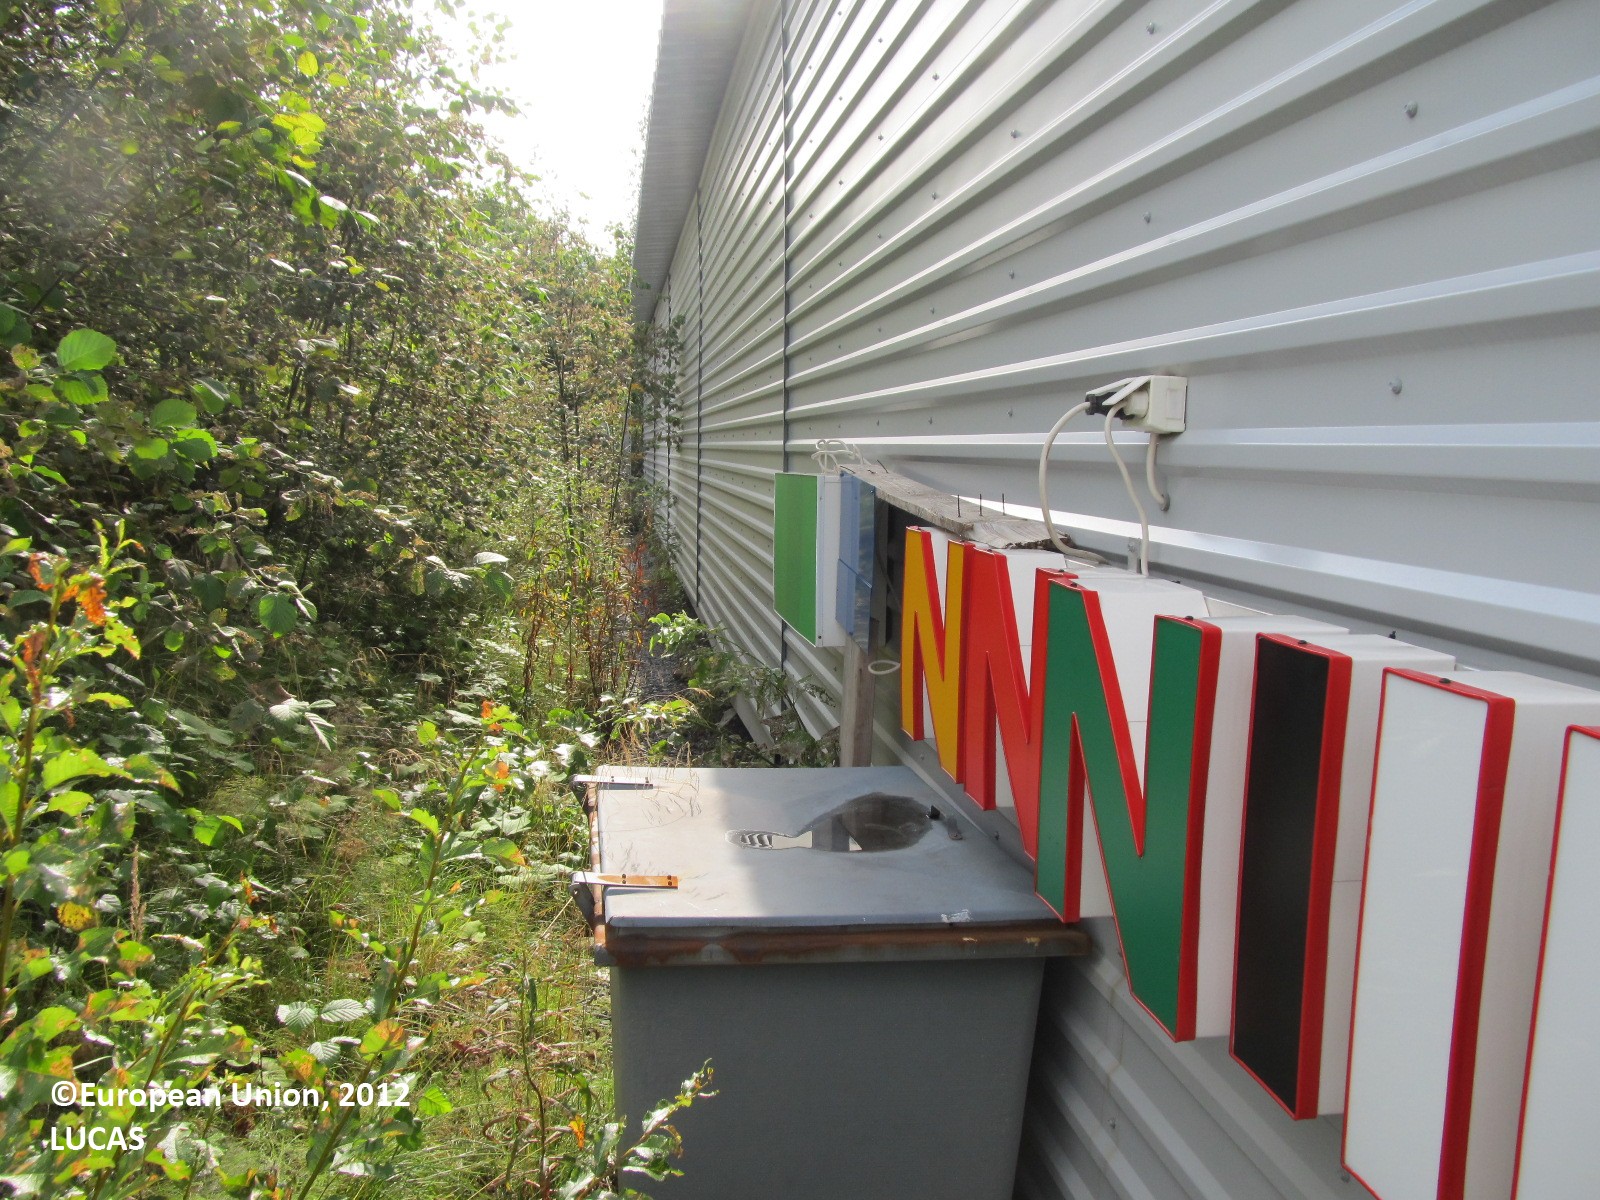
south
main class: Woodland
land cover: Pine dominated mixed woodland
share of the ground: 25 - 50 %
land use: Commerce, finance, business
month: August
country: FI
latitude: 62.9623
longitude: 27.6980
